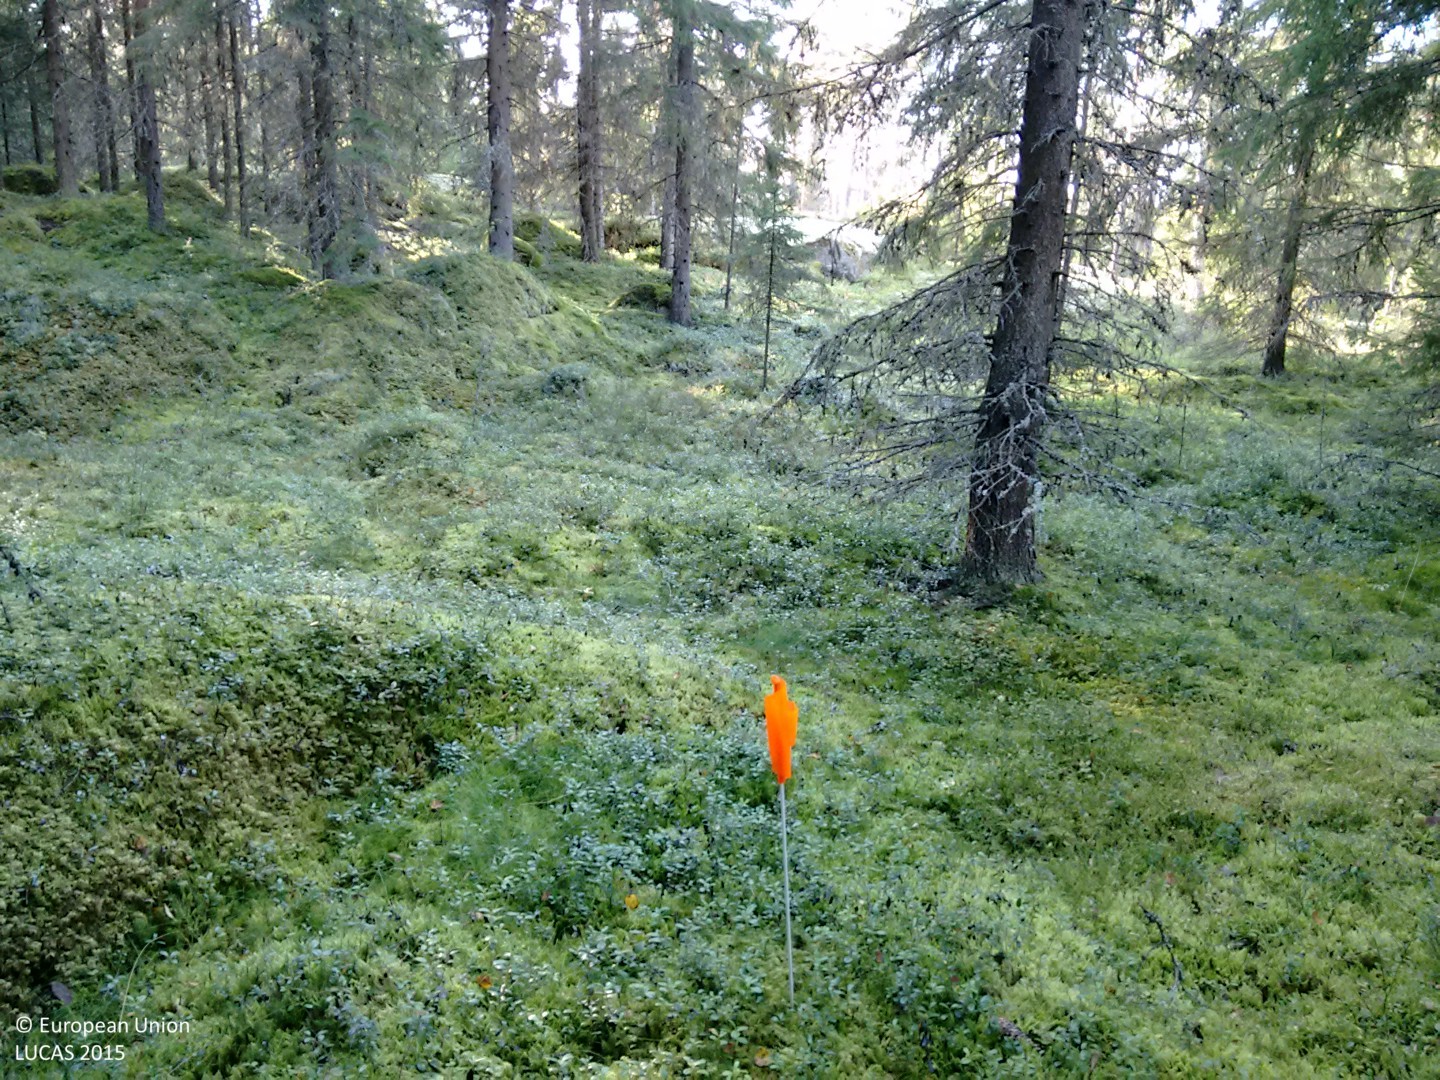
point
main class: Woodland
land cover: Spruce dominated coniferous woodland
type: hemiboreal forest and nemoral coniferous forest and mixed broadleaved-coniferous forest
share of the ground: > 75 %
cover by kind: coniferous forest trees 90 %, shrubs 5 %, lichens and mosses 5 %
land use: Forestry
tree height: > 5 m
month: September
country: FI
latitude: 60.9285
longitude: 21.9597
